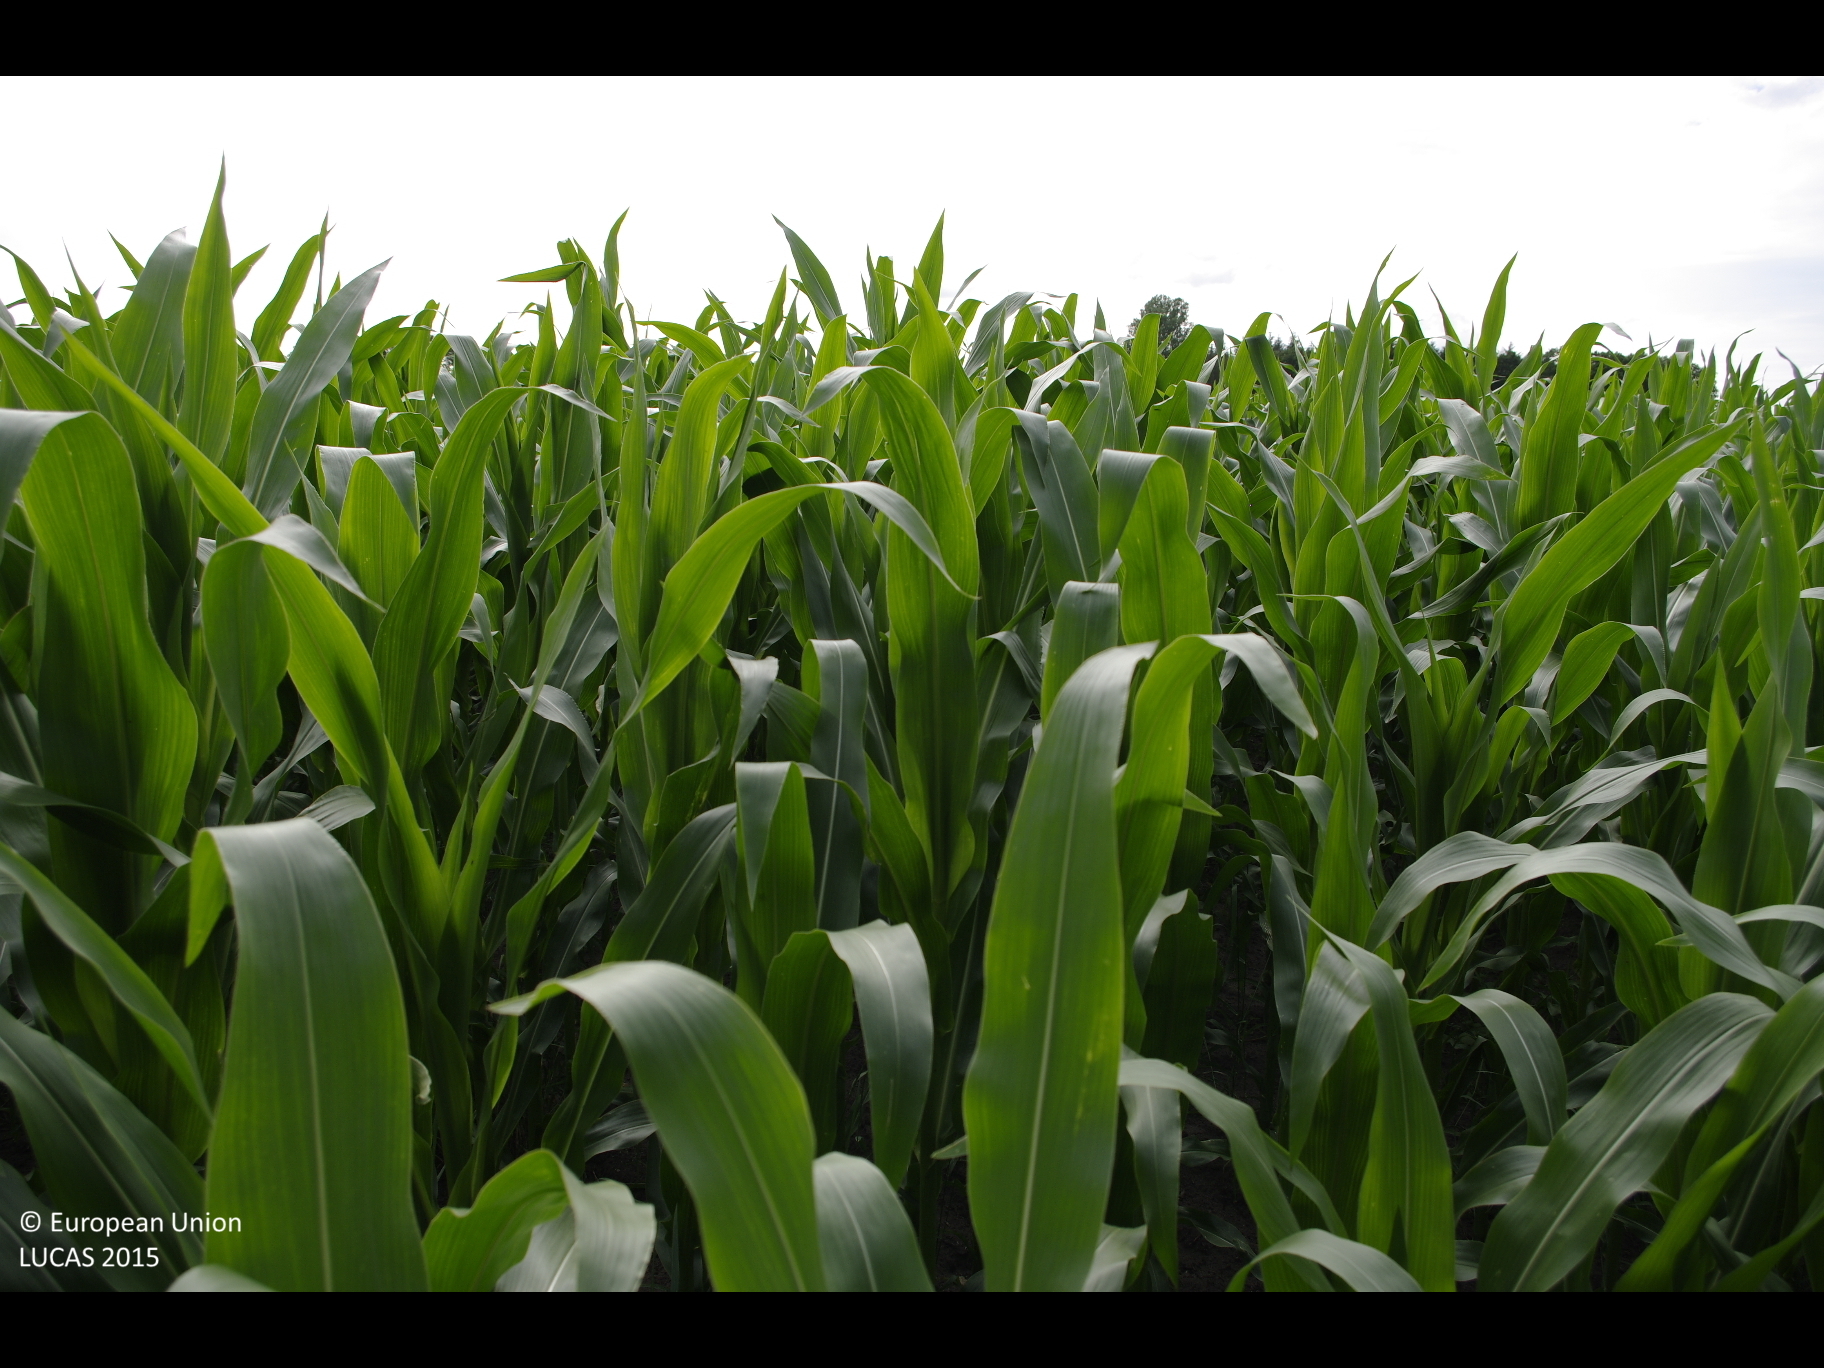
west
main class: Cropland
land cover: Maize
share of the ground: > 75 %
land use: Agriculture (excluding fallow land and kitchen gardens)
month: July
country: DE
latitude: 53.9950
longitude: 9.9543
